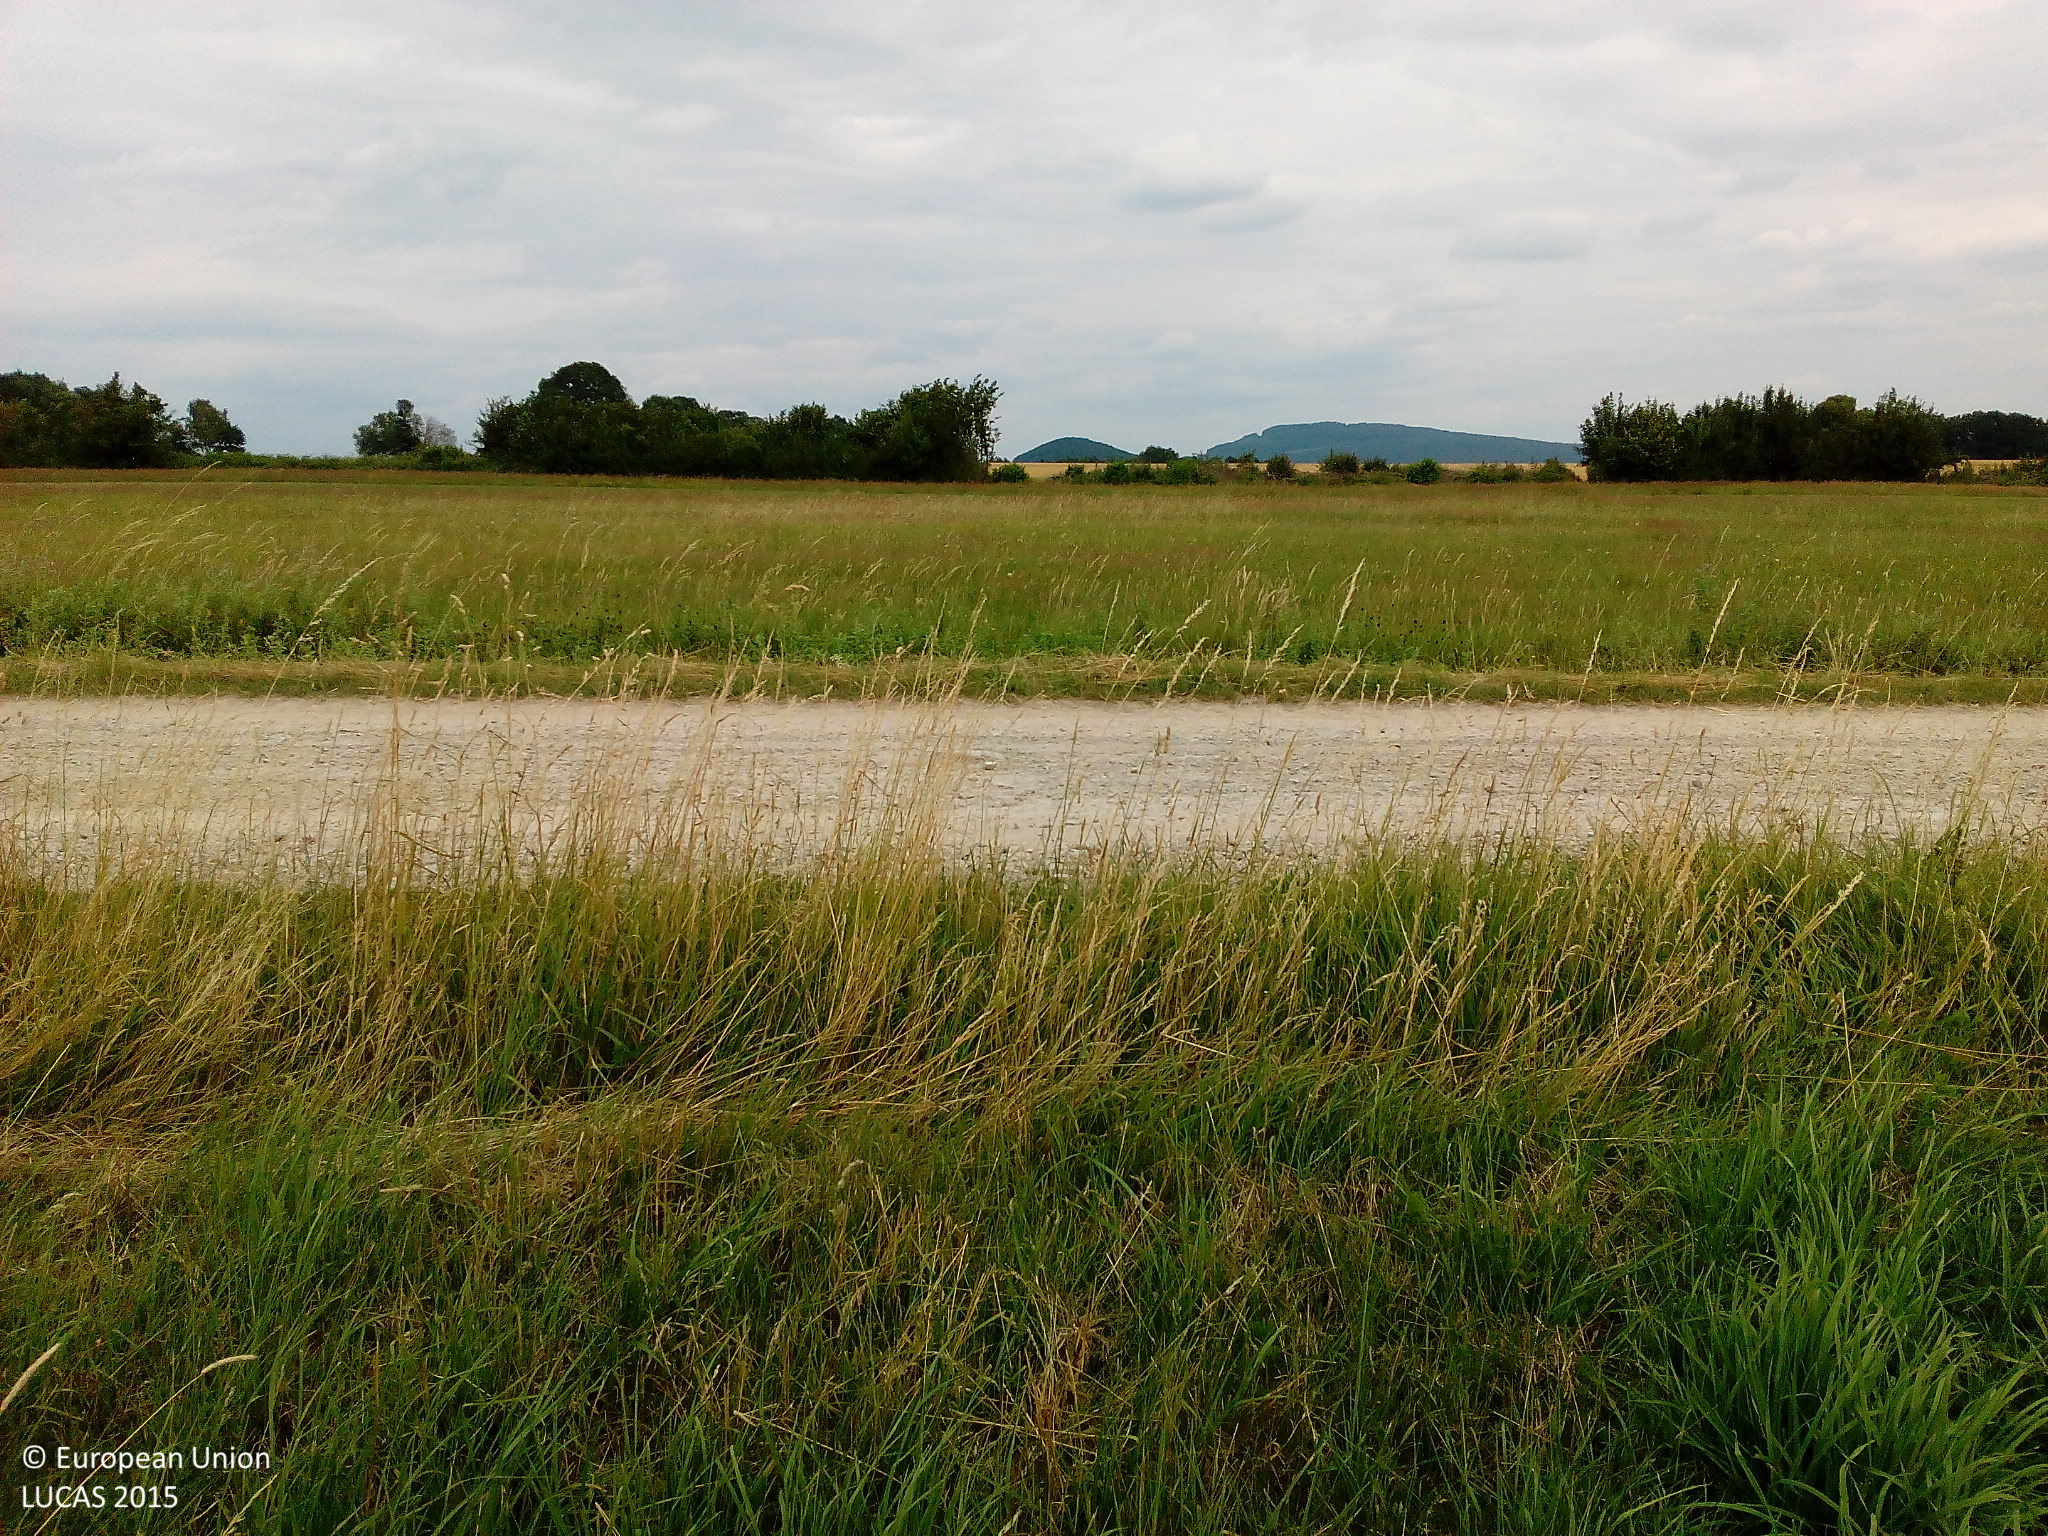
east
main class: Cropland
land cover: Barley
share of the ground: > 75 %
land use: Agriculture (excluding fallow land and kitchen gardens)
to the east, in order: Barley; Ditches and canals; Grass margins; Tracks; Grass margins; Ditches and canals; Grassland without tree/shrub cover; Broadleaved woodland; Grassland without tree/shrub cover
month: July
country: DE
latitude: 50.7955
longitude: 9.9291
